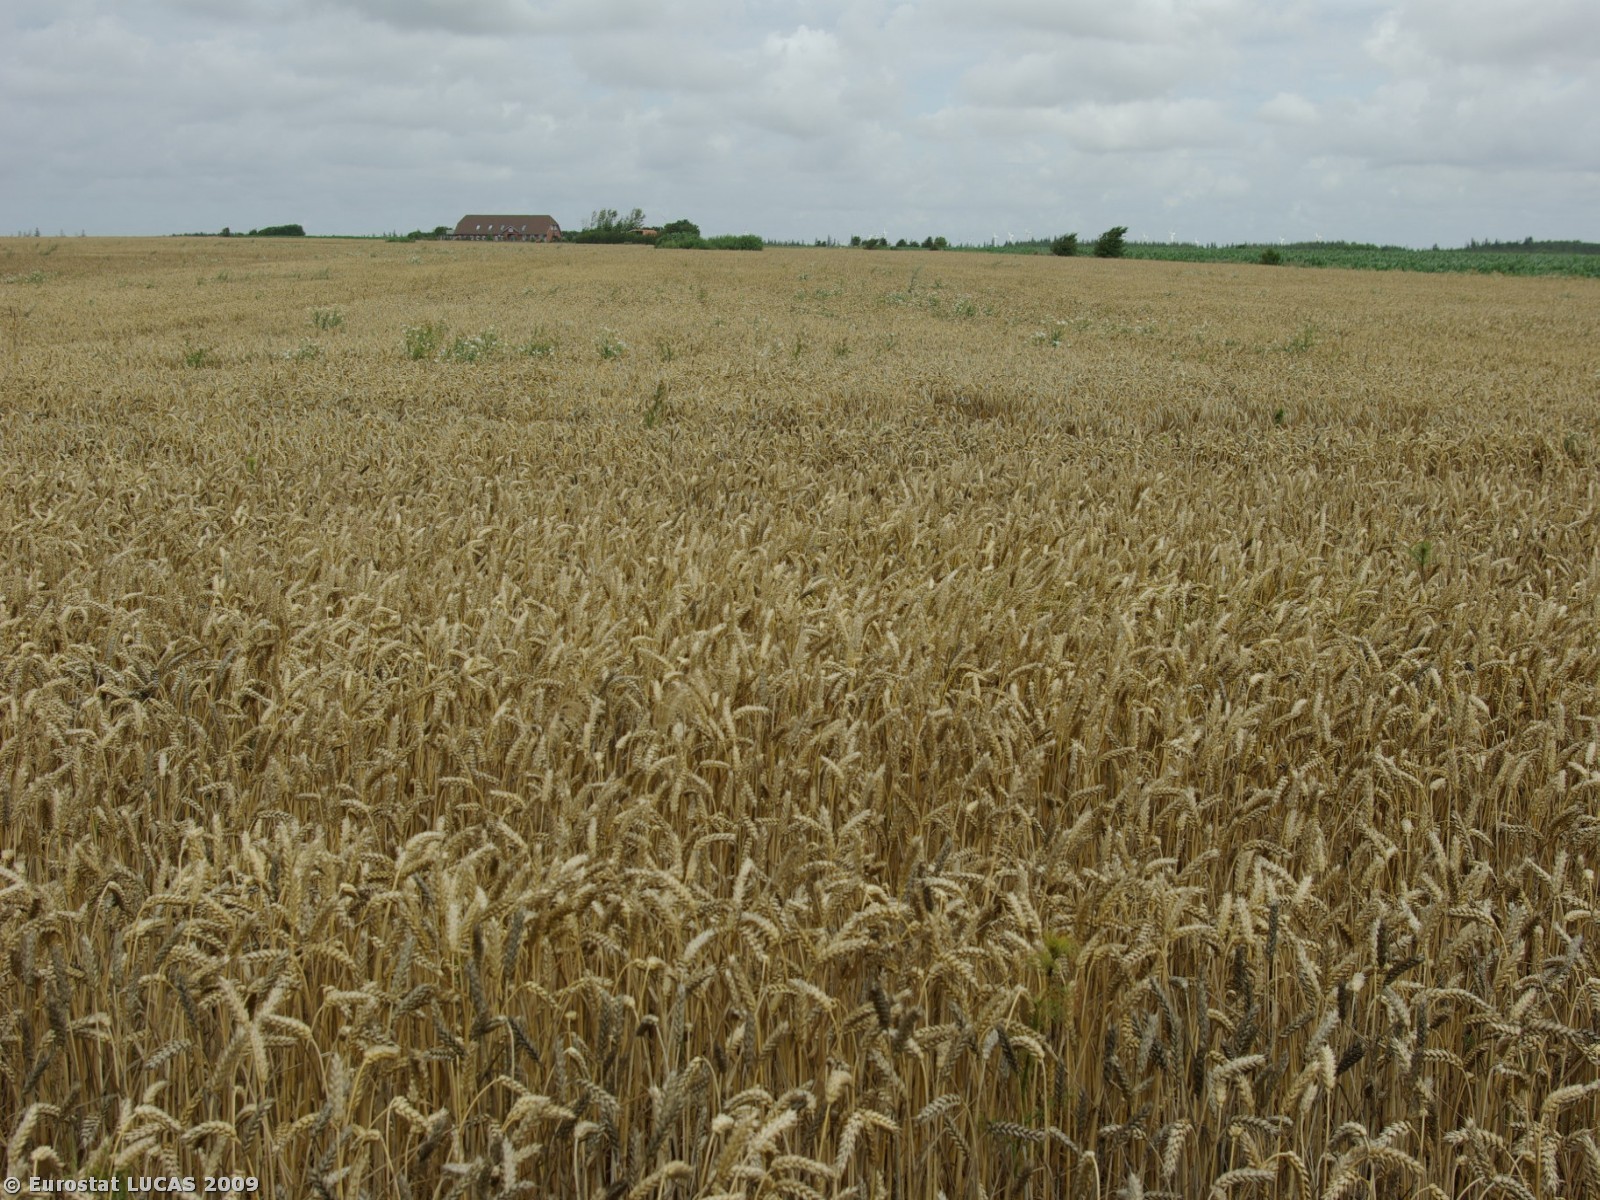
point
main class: Cropland
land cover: Common wheat
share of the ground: > 75 %
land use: Agriculture (excluding fallow land and kitchen gardens)
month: July
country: DK
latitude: 54.9944
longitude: 8.6724
